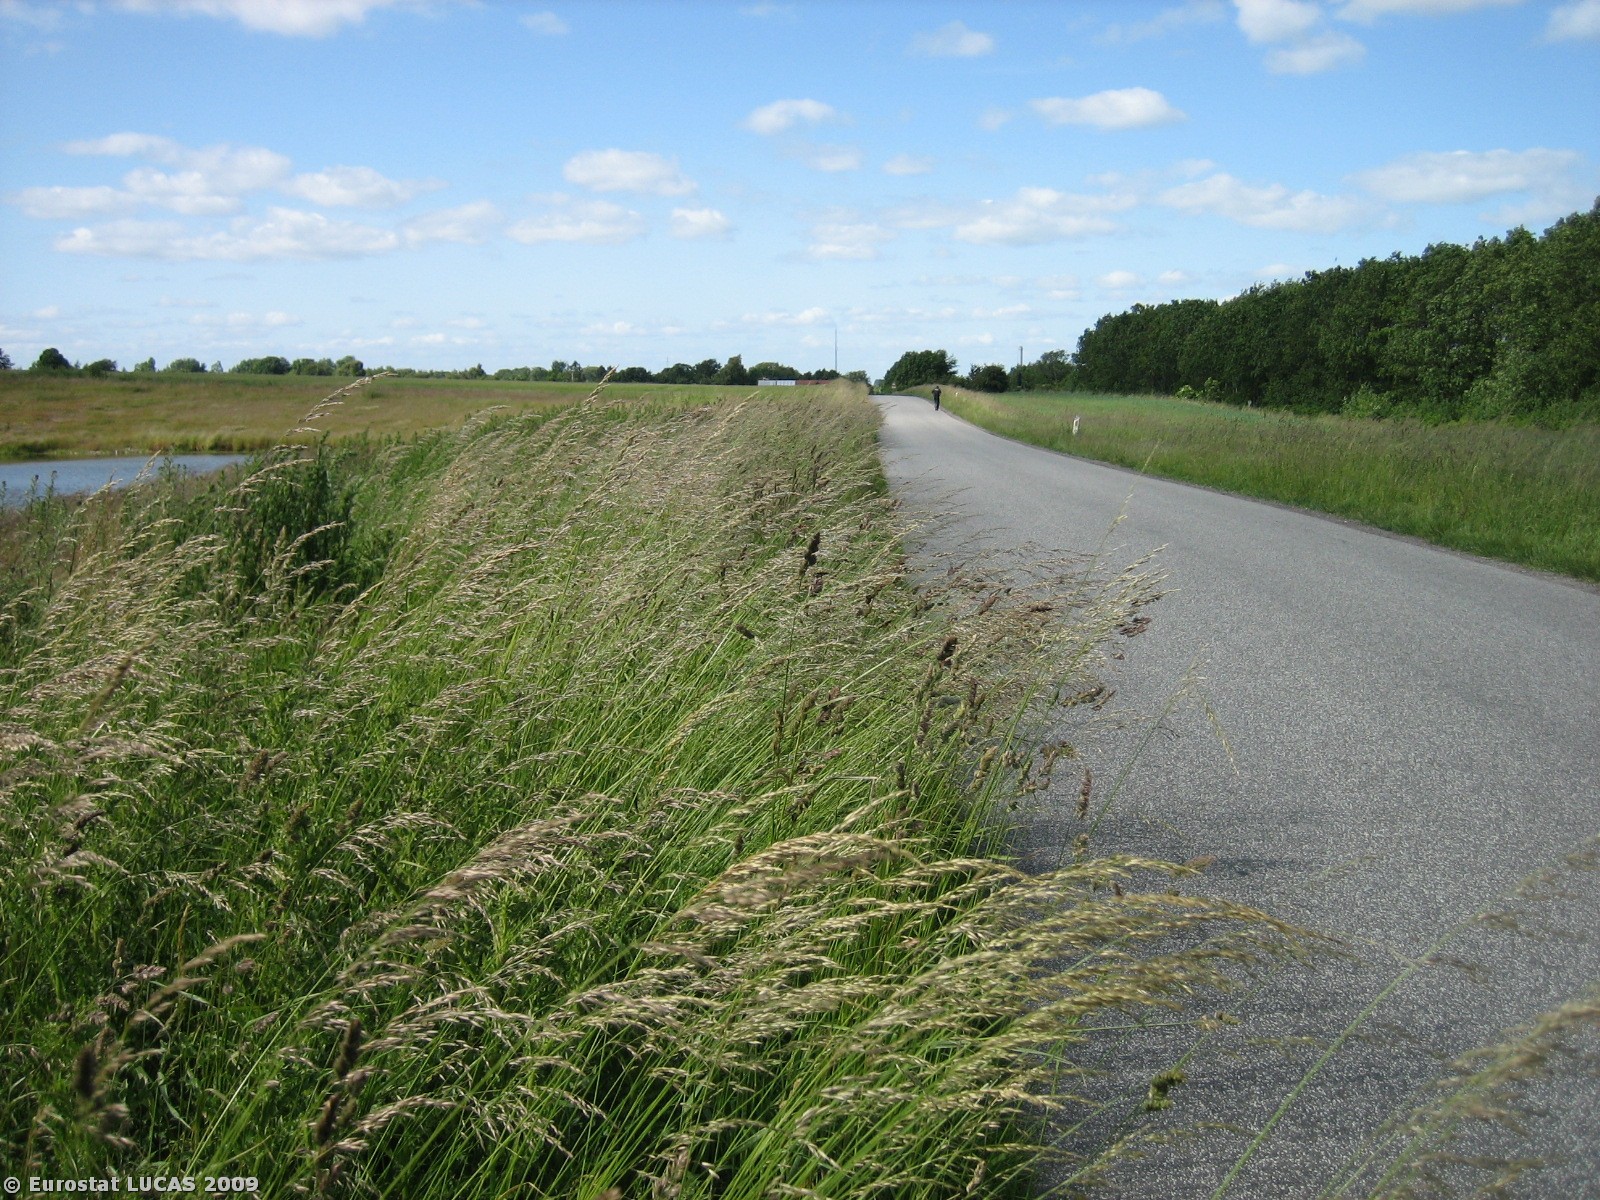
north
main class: Grassland
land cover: Grassland without tree/shrub cover
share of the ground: > 75 %
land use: Unused
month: June
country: DK
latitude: 55.7560
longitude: 9.6976
